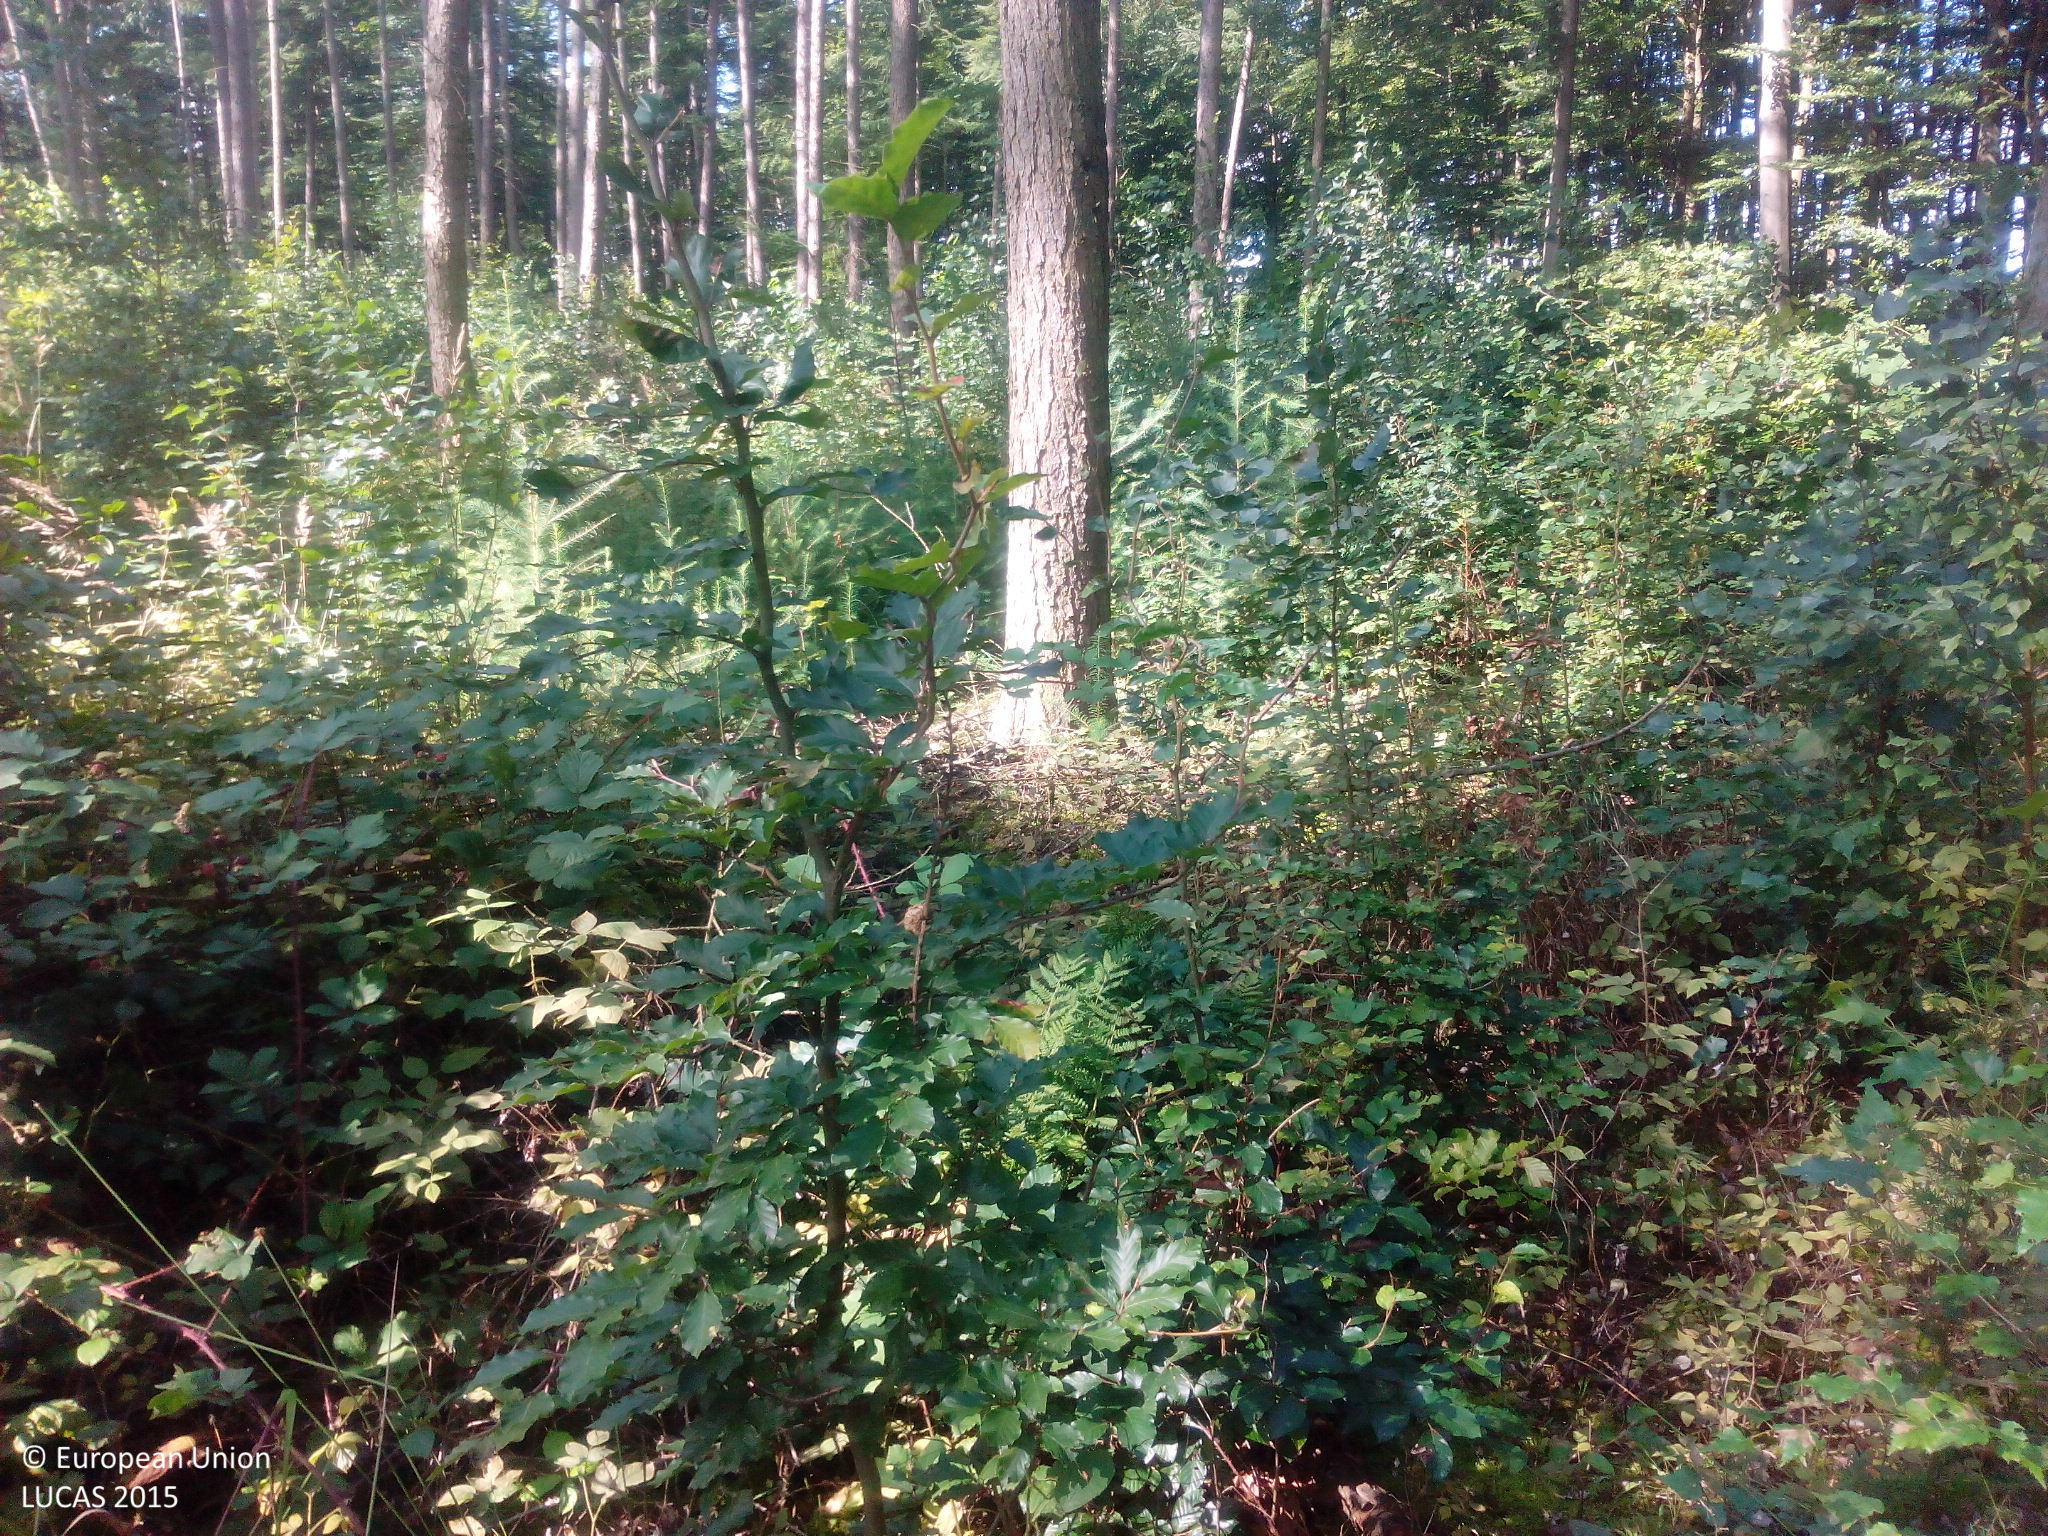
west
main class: Woodland
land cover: Other mixed woodland
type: hemiboreal forest and nemoral coniferous forest and mixed broadleaved-coniferous forest
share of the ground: > 75 %
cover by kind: coniferous forest trees 70 %, broadleaved forest trees 25 %, shrubs 5 %
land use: Forestry
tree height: > 5 m
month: September
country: DE
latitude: 54.1171
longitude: 12.3091
